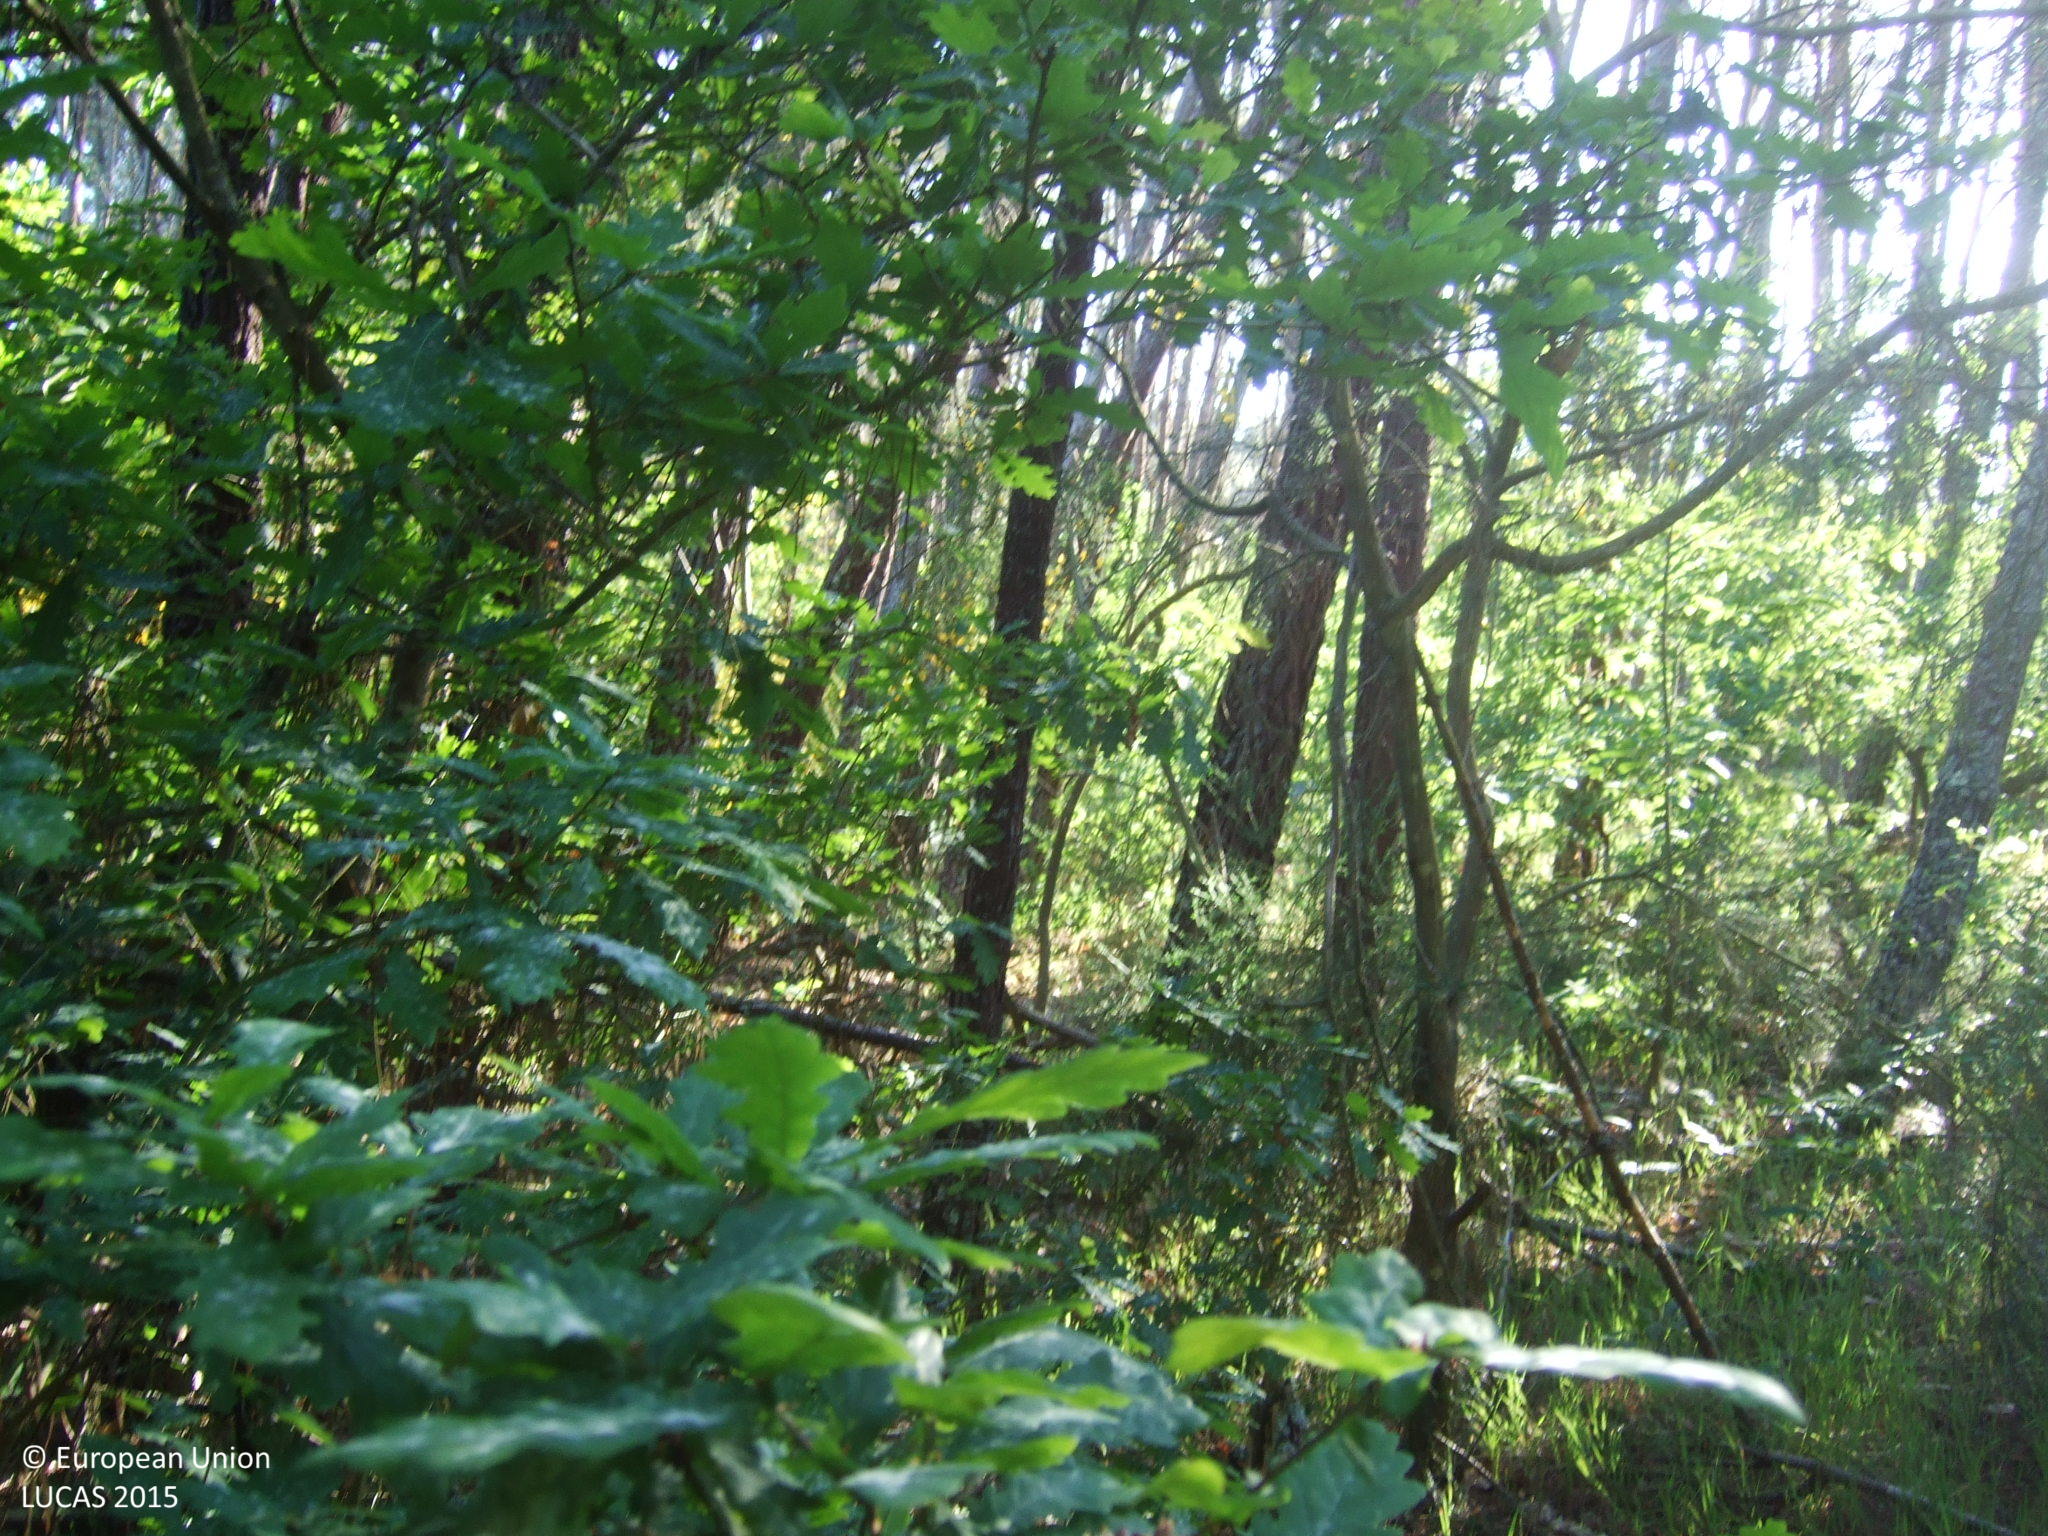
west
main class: Woodland
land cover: Pine dominated coniferous woodland
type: exotic forest
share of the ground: 50 - 75 %
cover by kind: coniferous forest trees 65 %, unconsolidated bare surface 20 %, shrubs 10 %, broadleaved forest trees 5 %
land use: Forestry
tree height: > 5 m
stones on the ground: < 10 %
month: May
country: ES
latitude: 42.7339
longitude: -7.5269
